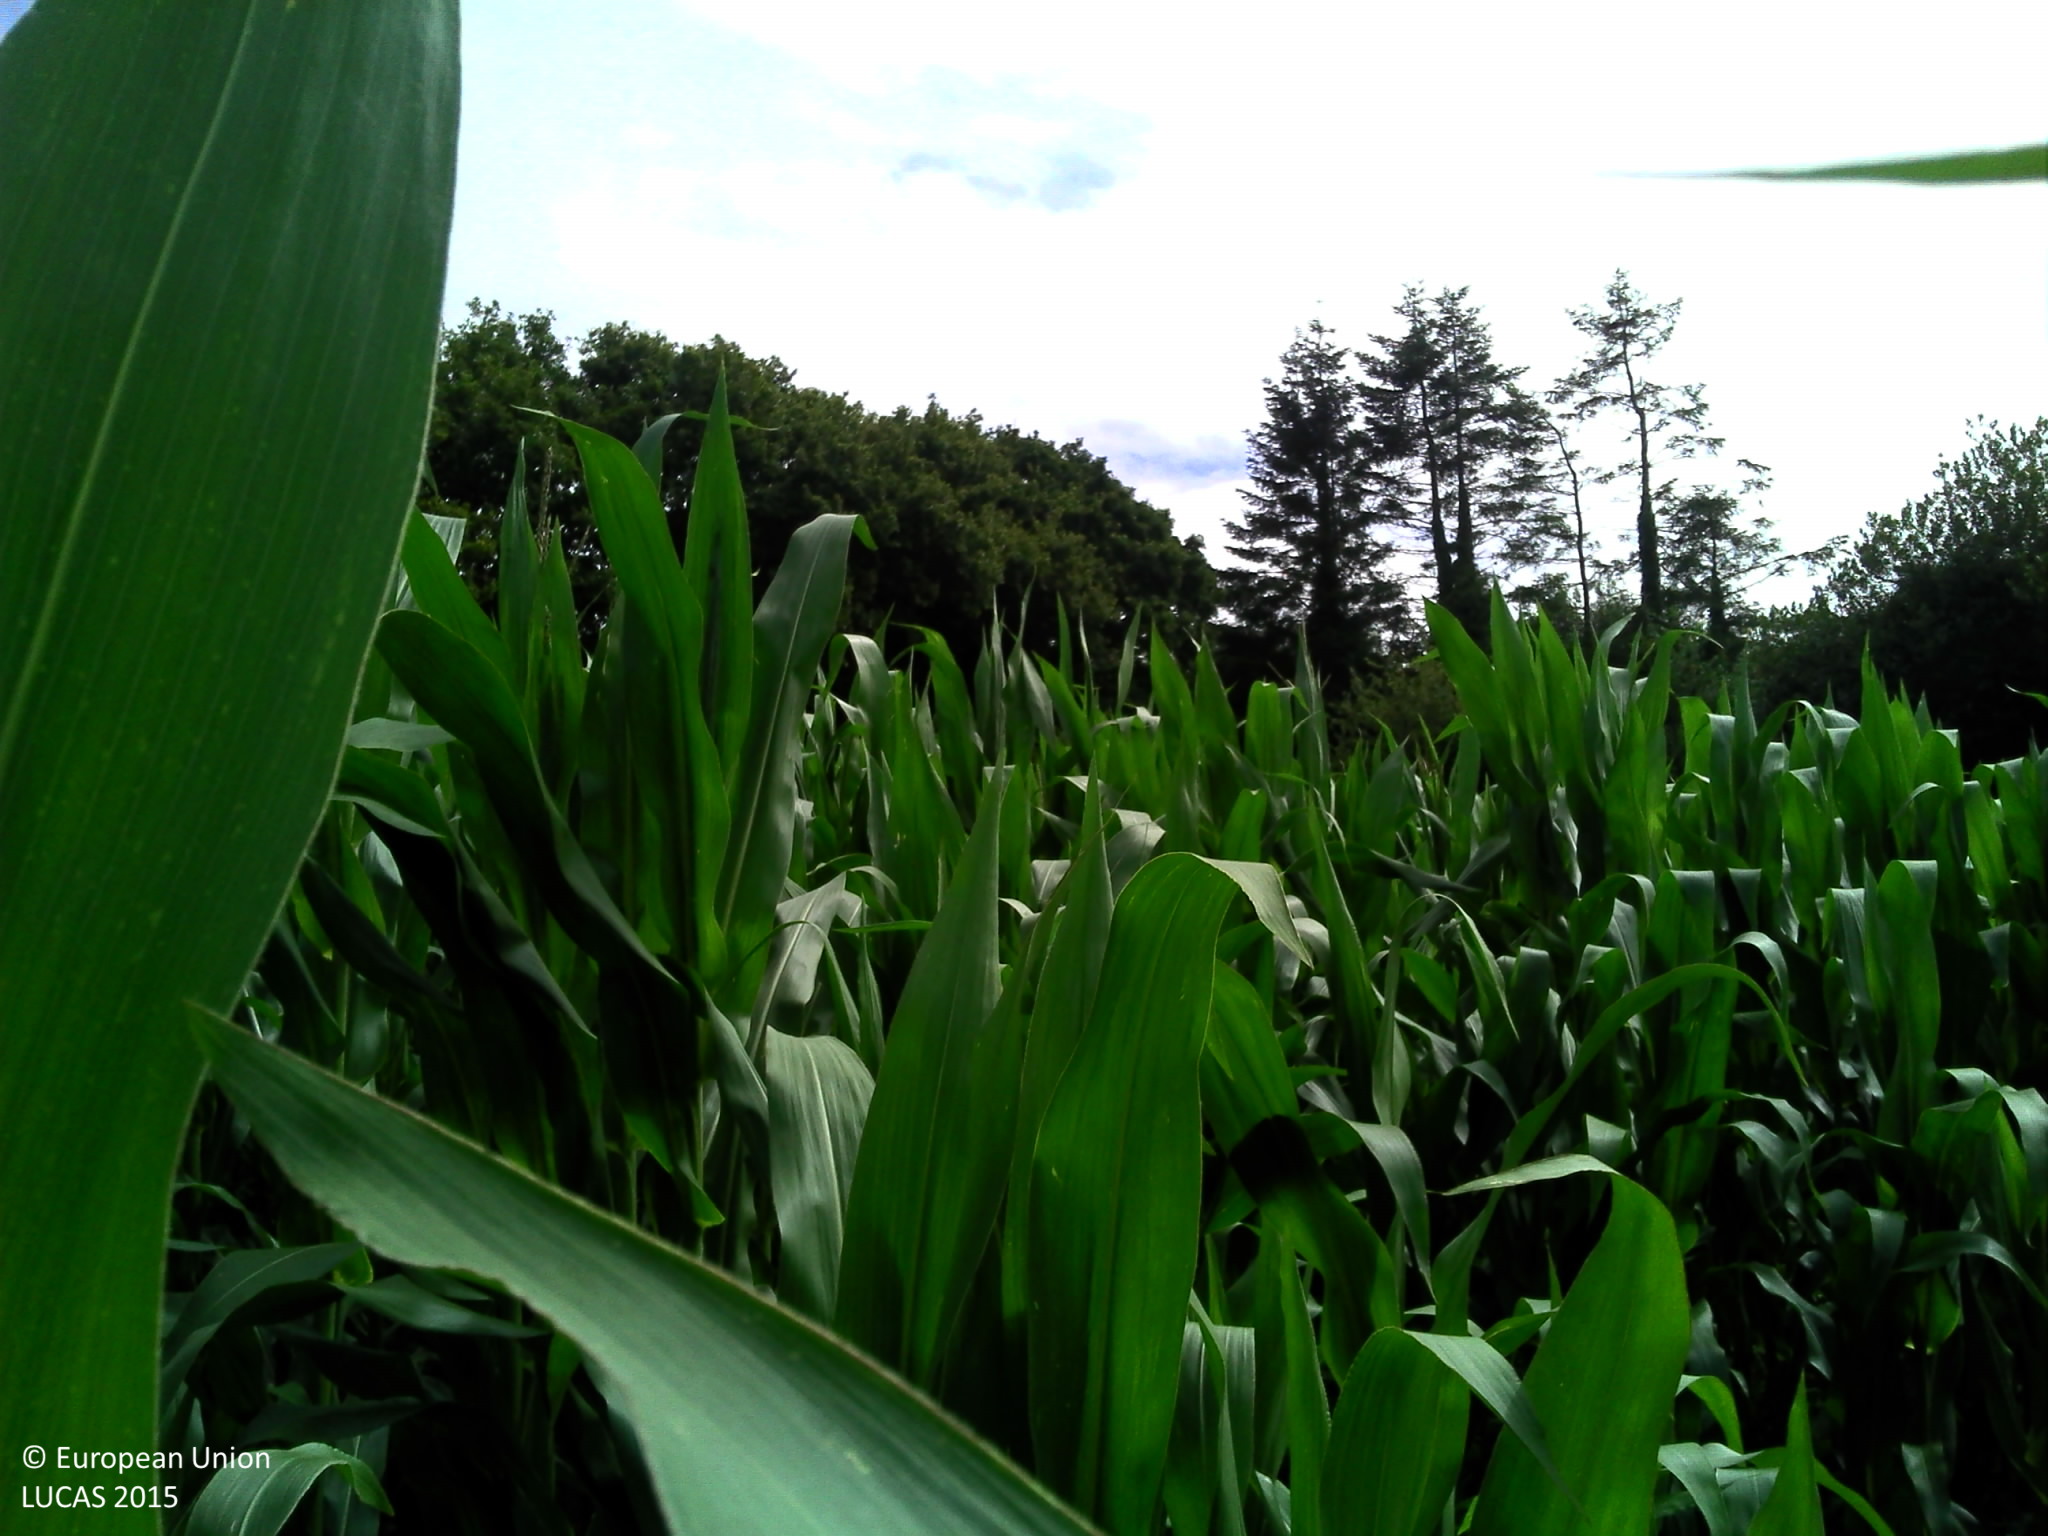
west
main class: Cropland
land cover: Maize
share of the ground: > 75 %
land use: Agriculture (excluding fallow land and kitchen gardens)
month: August
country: FR
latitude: 48.4590
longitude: -3.3969
